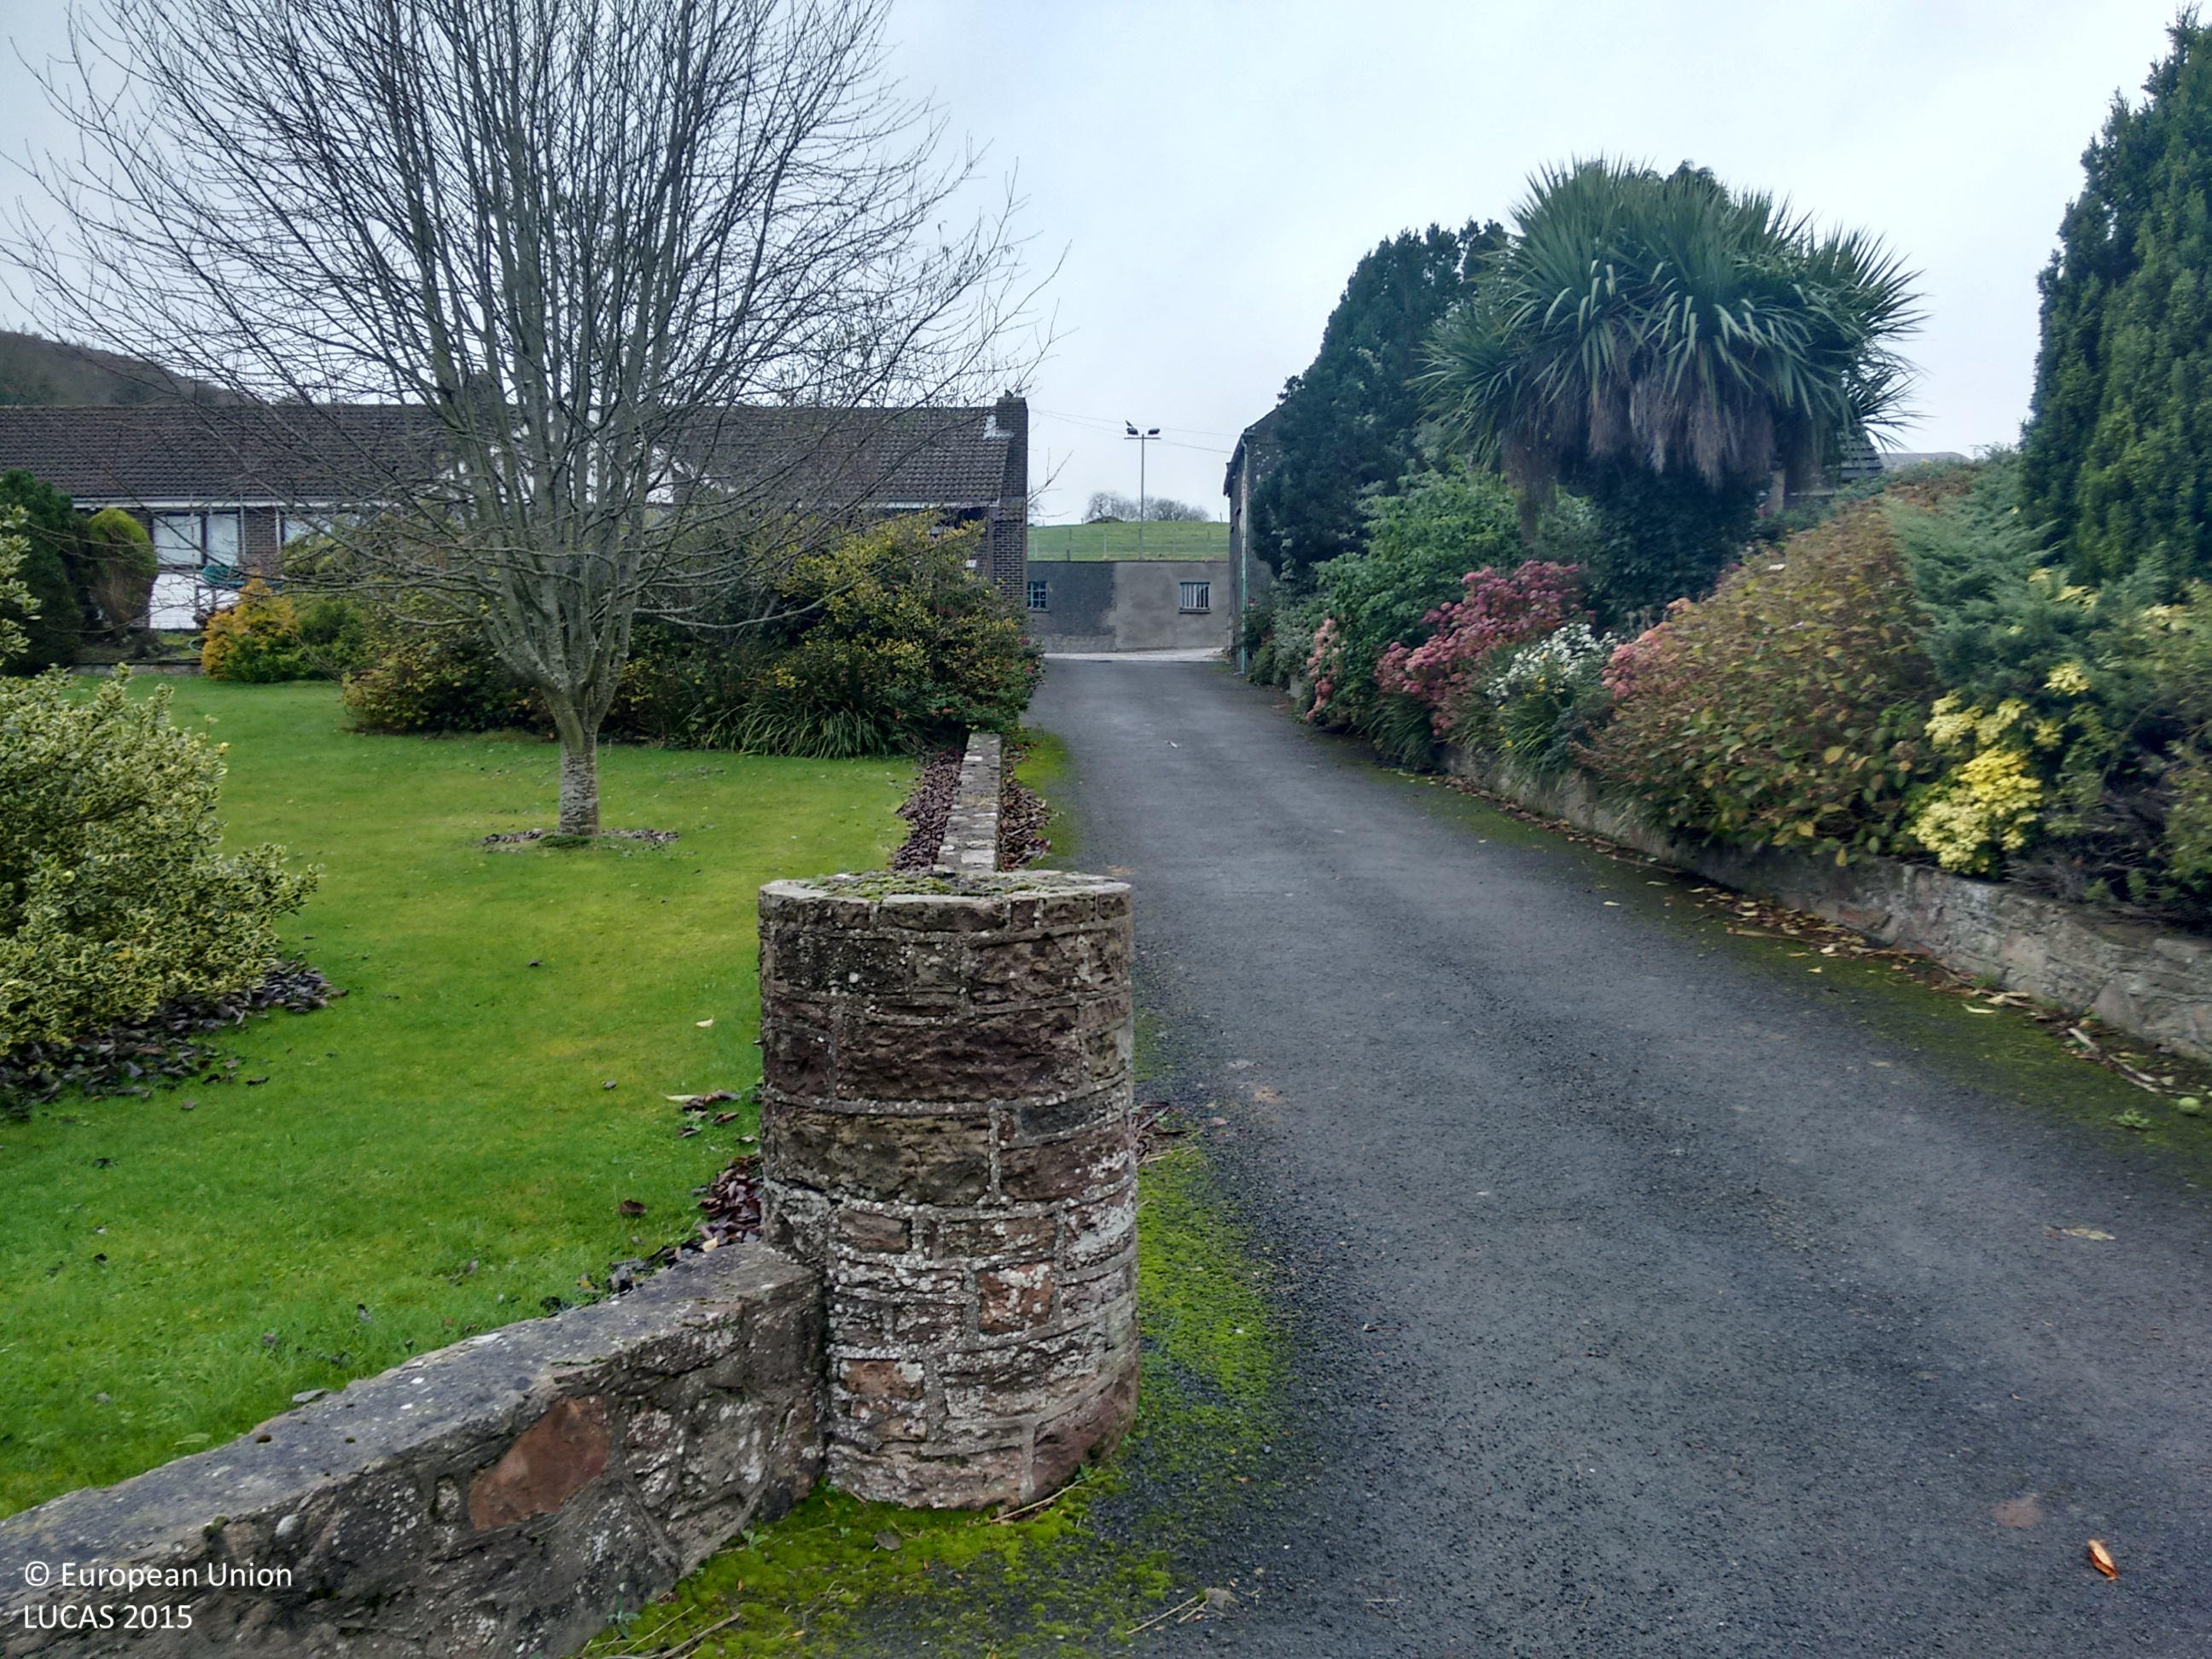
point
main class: Grassland
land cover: Grassland without tree/shrub cover
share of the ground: > 75 %
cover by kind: herbaceous plants 100 %
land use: Agriculture (excluding fallow land and kitchen gardens)
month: November
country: GB
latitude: 54.5862
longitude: -5.7152
